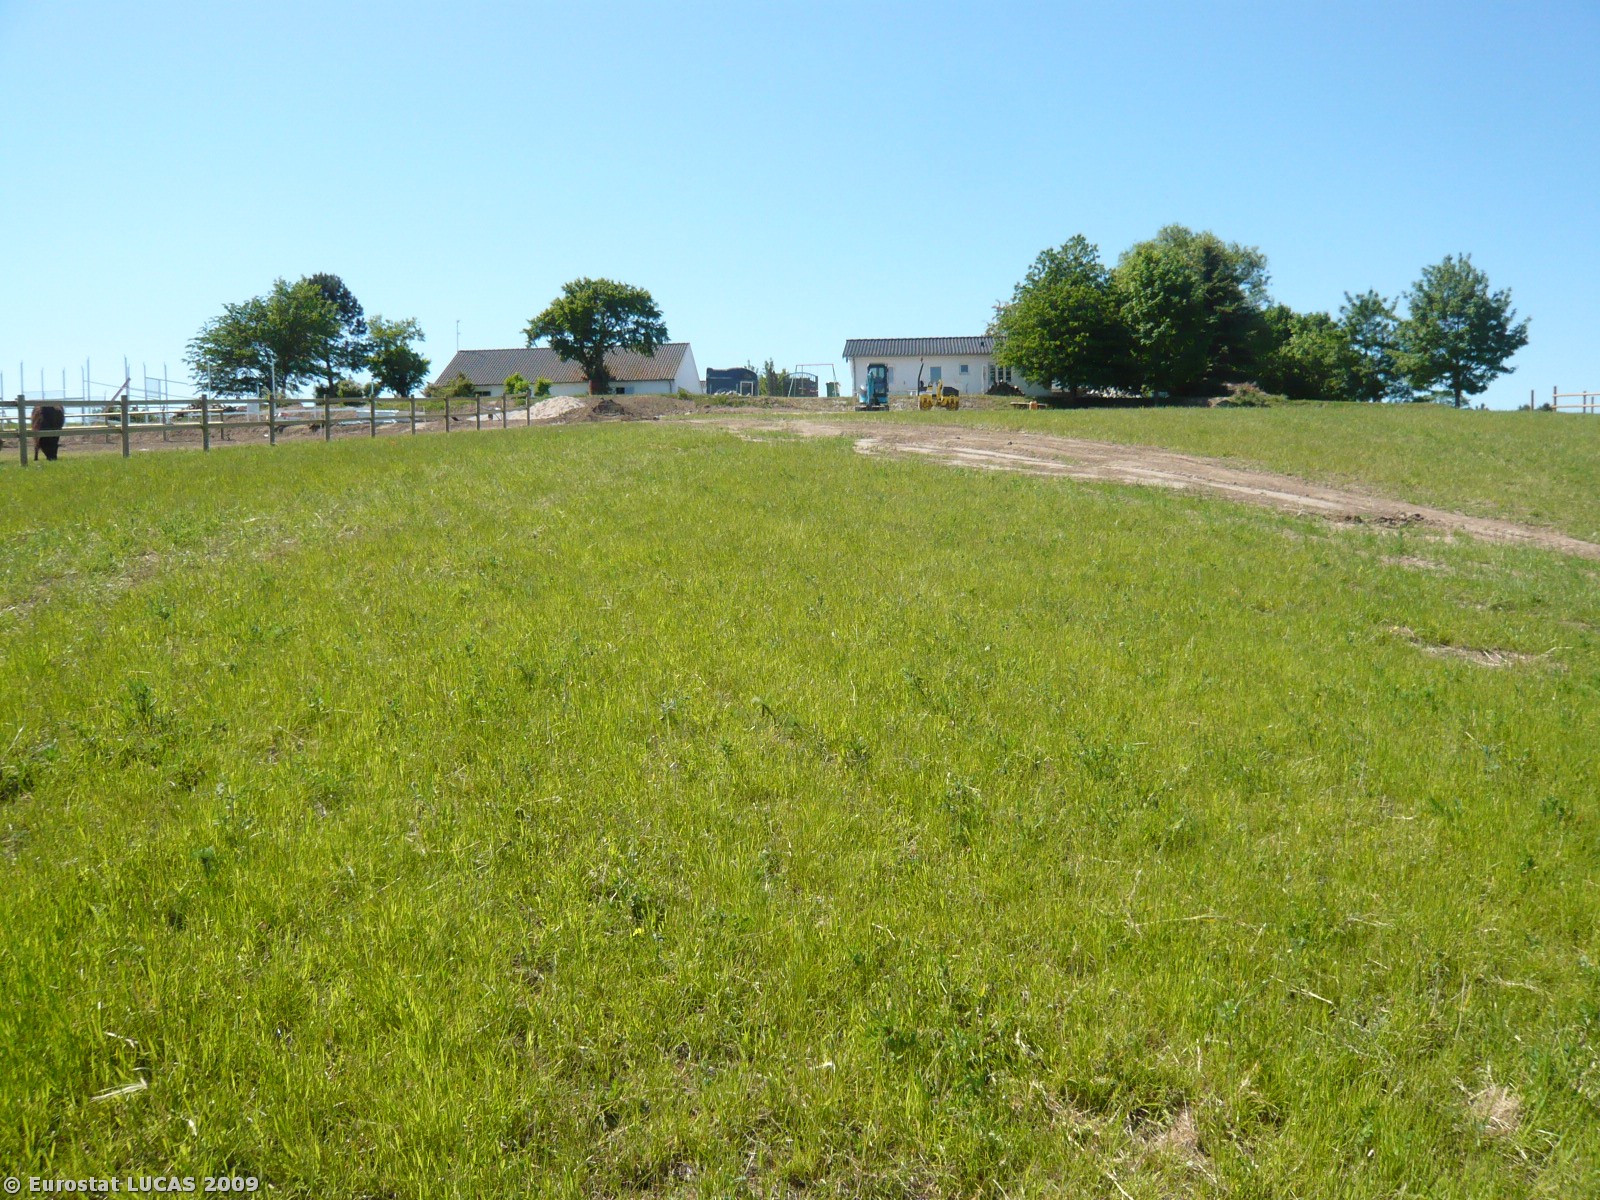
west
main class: Grassland
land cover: Grassland without tree/shrub cover
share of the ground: > 75 %
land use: Agriculture (excluding fallow land and kitchen gardens)
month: June
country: DK
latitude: 55.6505
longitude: 12.0165
